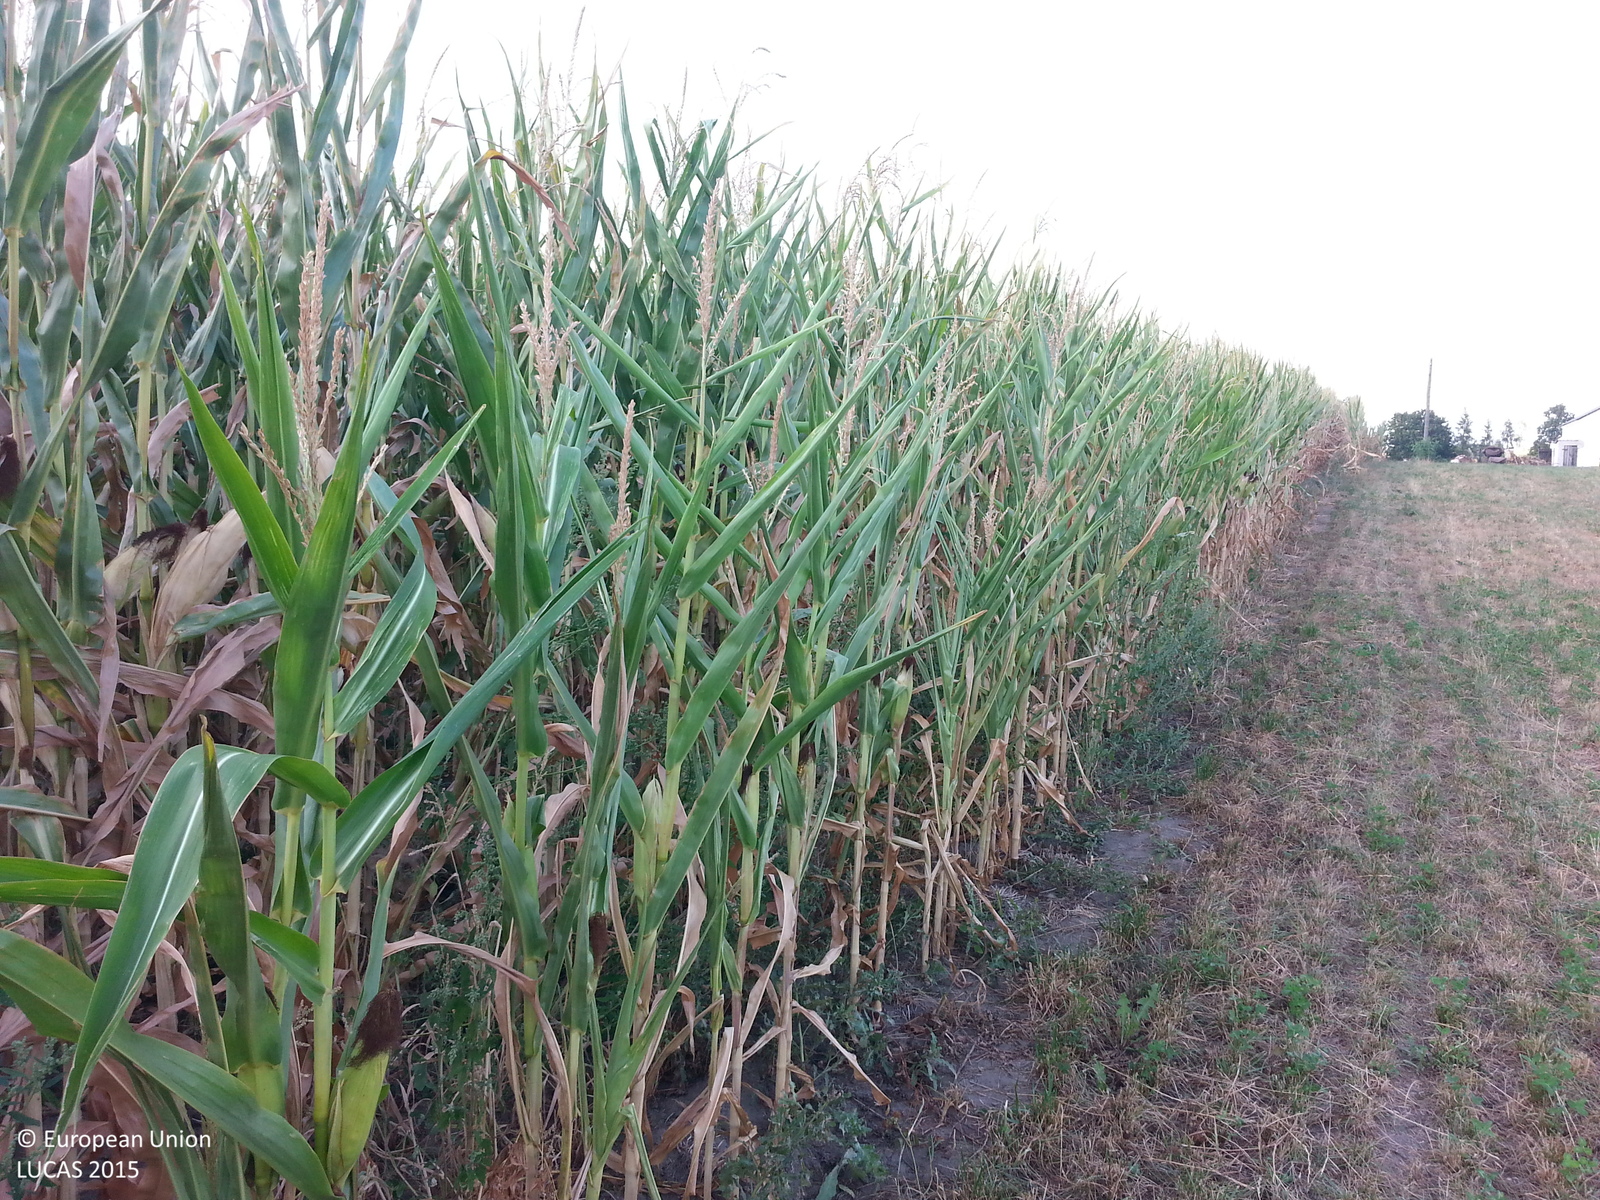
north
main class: Cropland
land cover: Maize
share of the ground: > 75 %
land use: Agriculture (excluding fallow land and kitchen gardens)
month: August
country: PL
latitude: 52.9311
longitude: 19.1135
